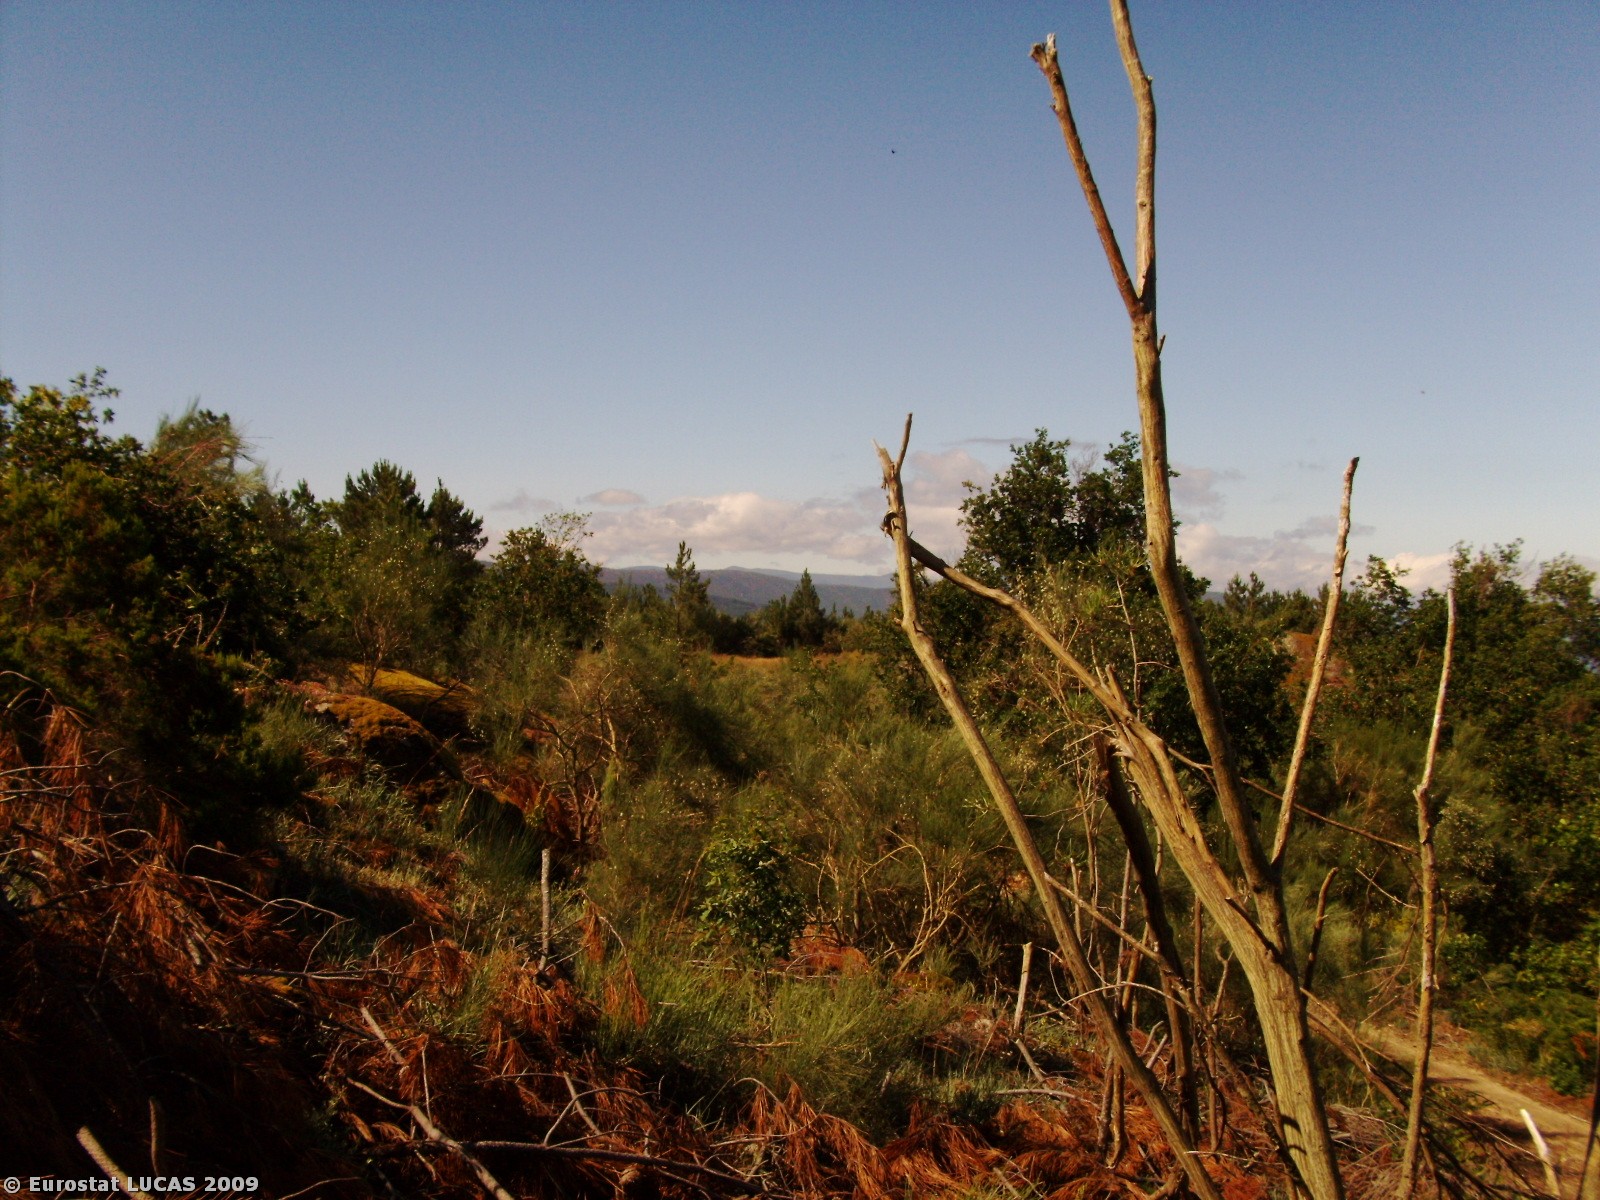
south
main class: Woodland
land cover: Coniferous woodland
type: coniferous forest of the mediterranean region
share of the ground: 10 - 25 %
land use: Forestry
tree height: > 5 m
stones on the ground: < 10 %
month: June
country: PT
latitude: 40.3968
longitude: -7.7046
